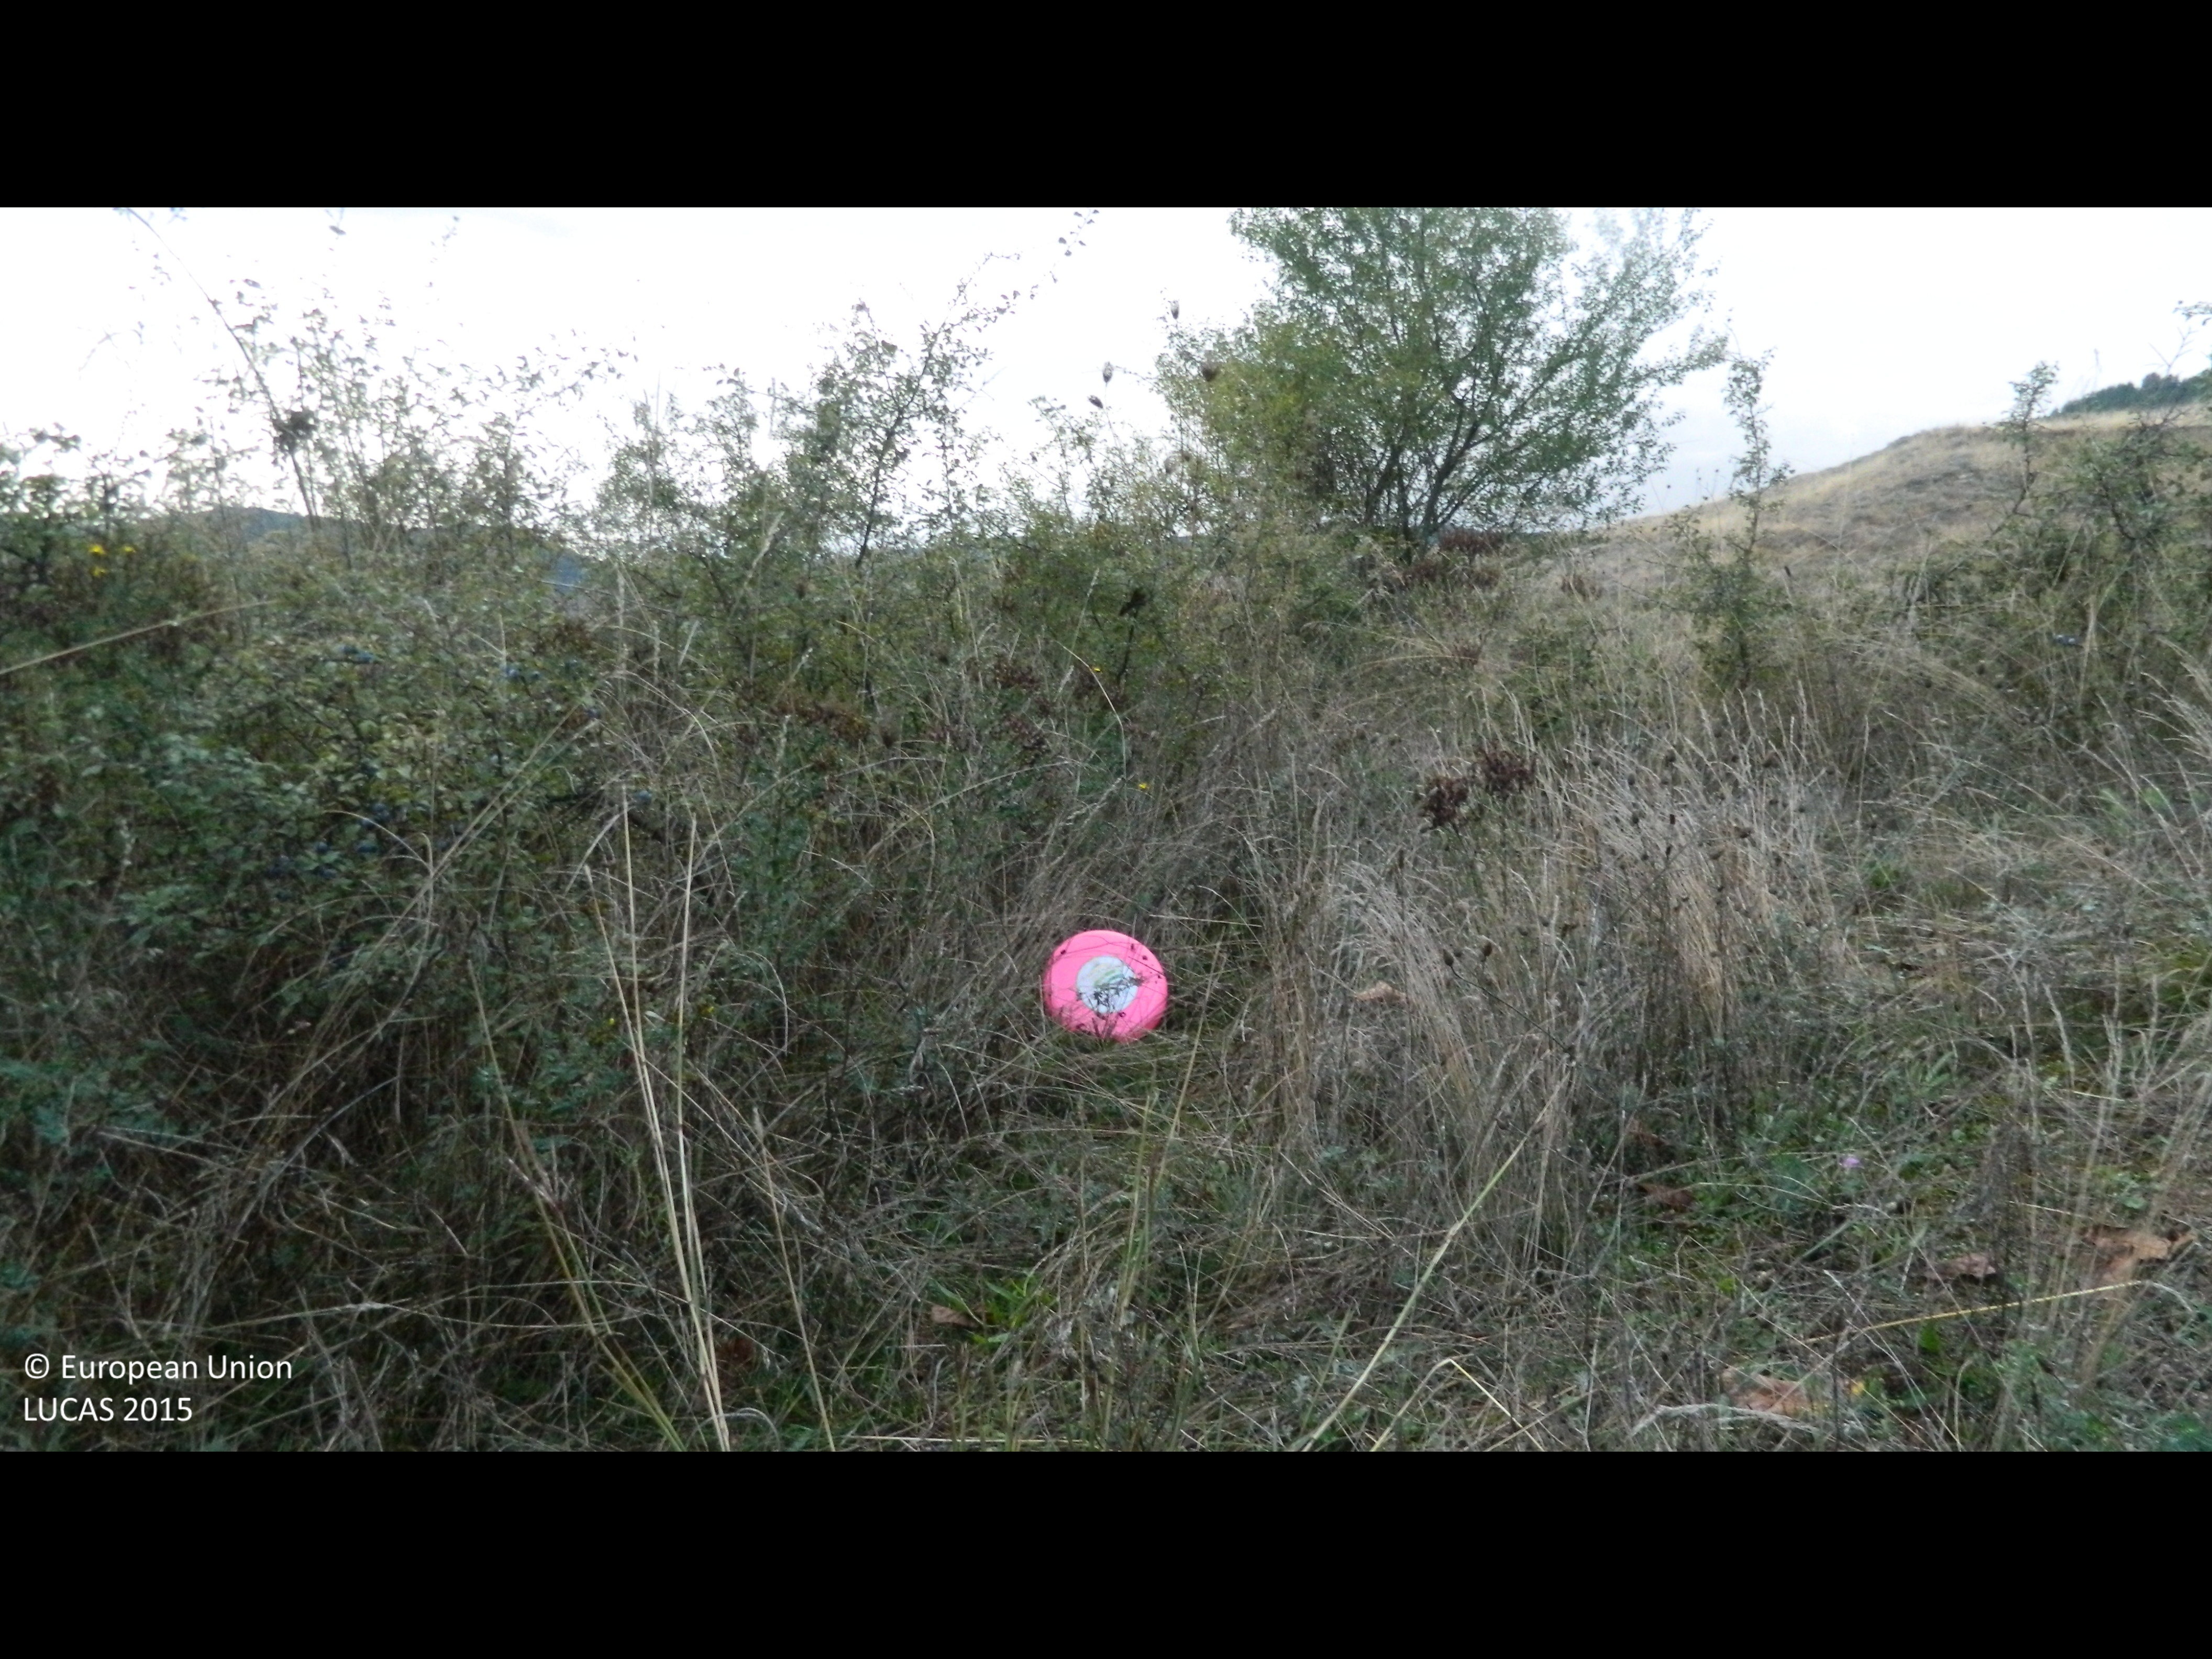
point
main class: Shrubland
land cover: Shrubland with sparse tree cover
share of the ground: > 75 %
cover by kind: shrubs 75 %, herbaceous plants 20 %, broadleaved forest trees 5 %
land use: Abandoned areas
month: September
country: BG
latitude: 41.5948
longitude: 24.0579
